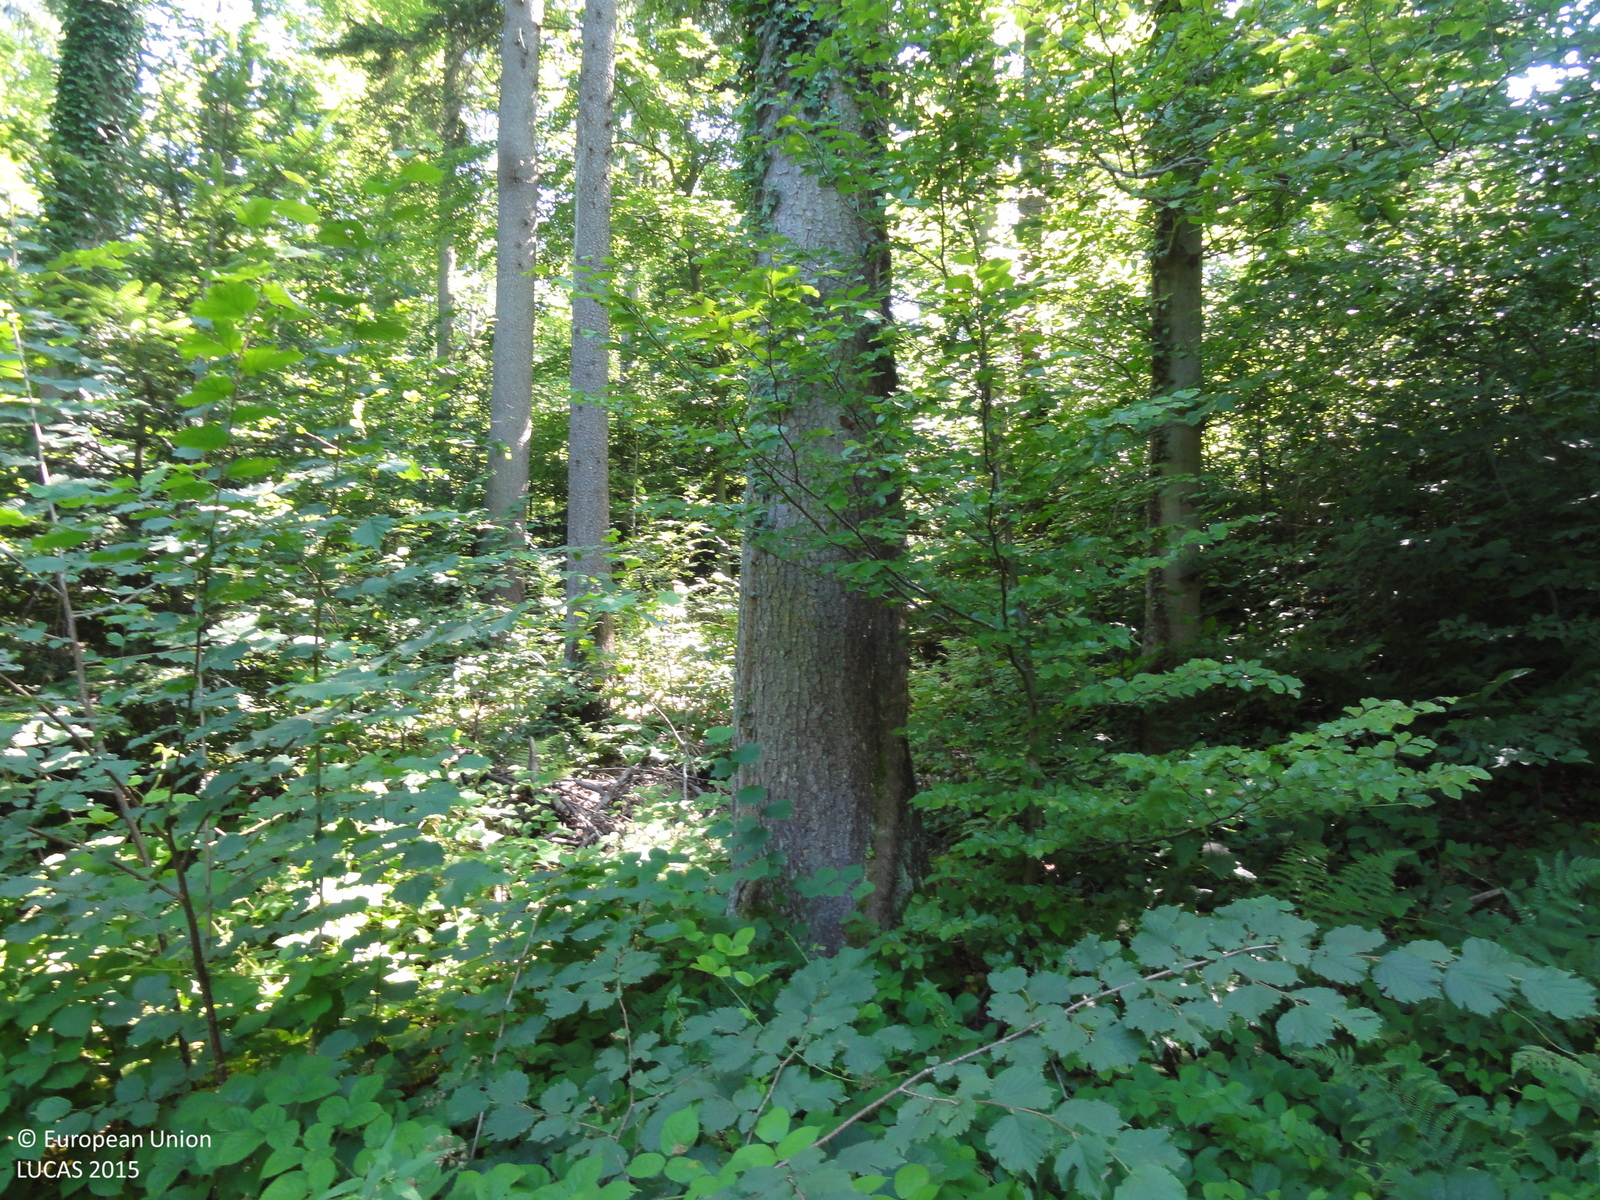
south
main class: Woodland
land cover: Spruce dominated mixed woodland
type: mountainous beech forest
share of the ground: > 75 %
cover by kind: coniferous forest trees 50 %, broadleaved forest trees 50 %
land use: Forestry
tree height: > 5 m
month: July
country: SI
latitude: 46.3389
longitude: 15.0775
